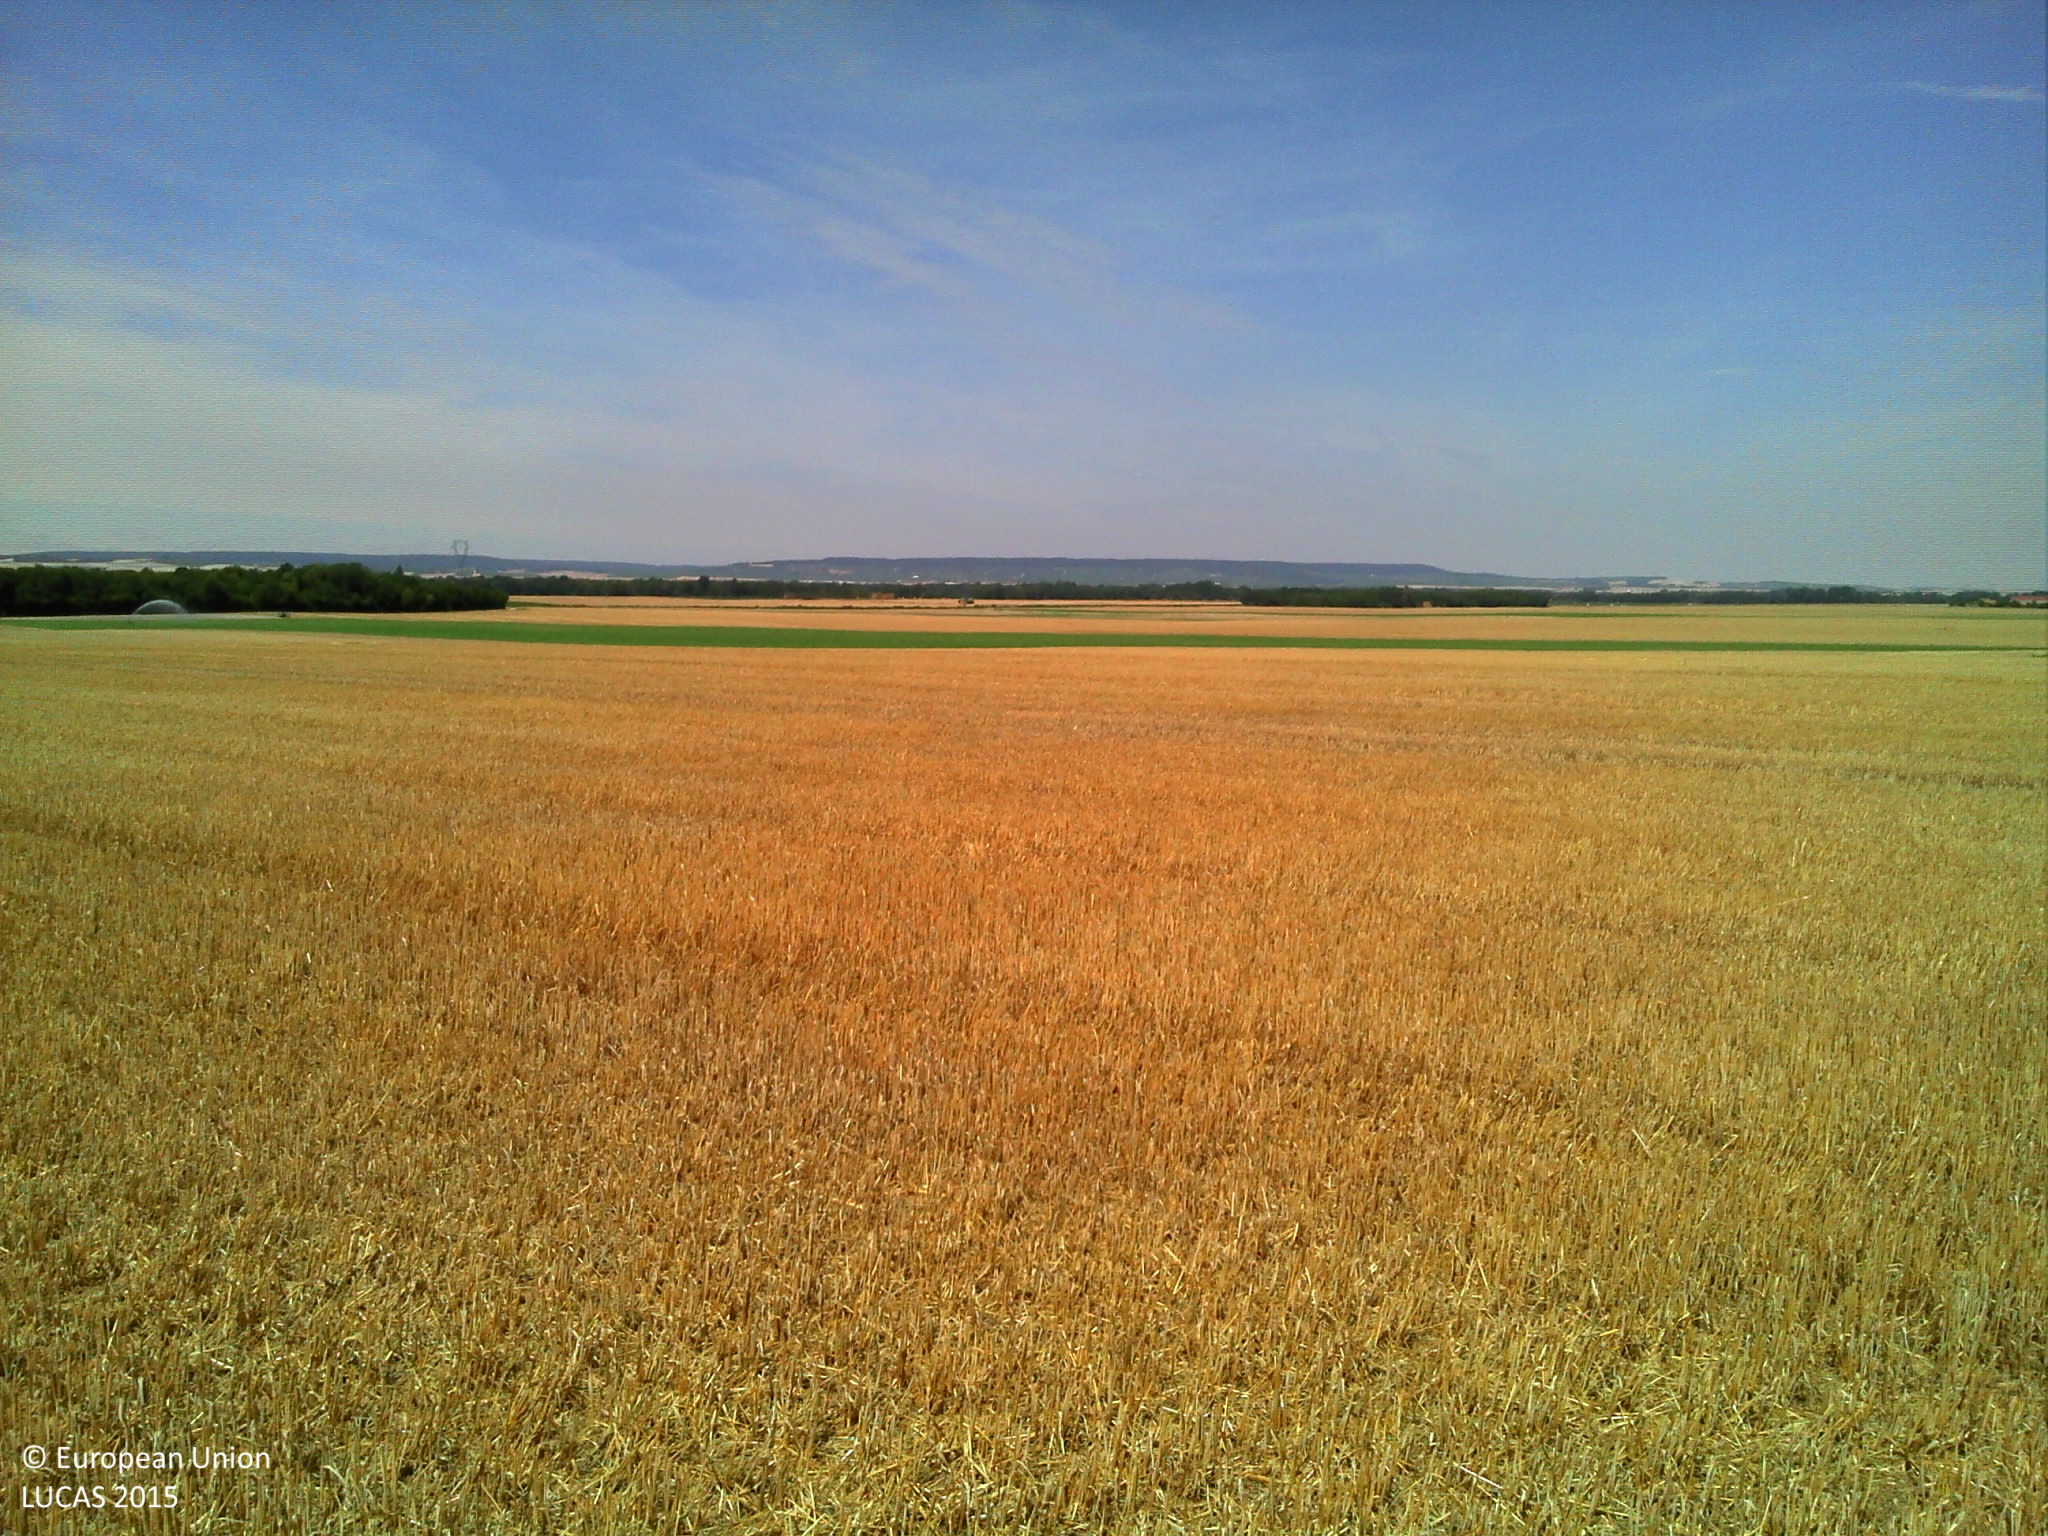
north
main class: Cropland
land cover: Barley
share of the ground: > 75 %
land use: Agriculture (excluding fallow land and kitchen gardens)
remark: Harvested field
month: August
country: FR
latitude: 48.9887
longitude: 4.1604
